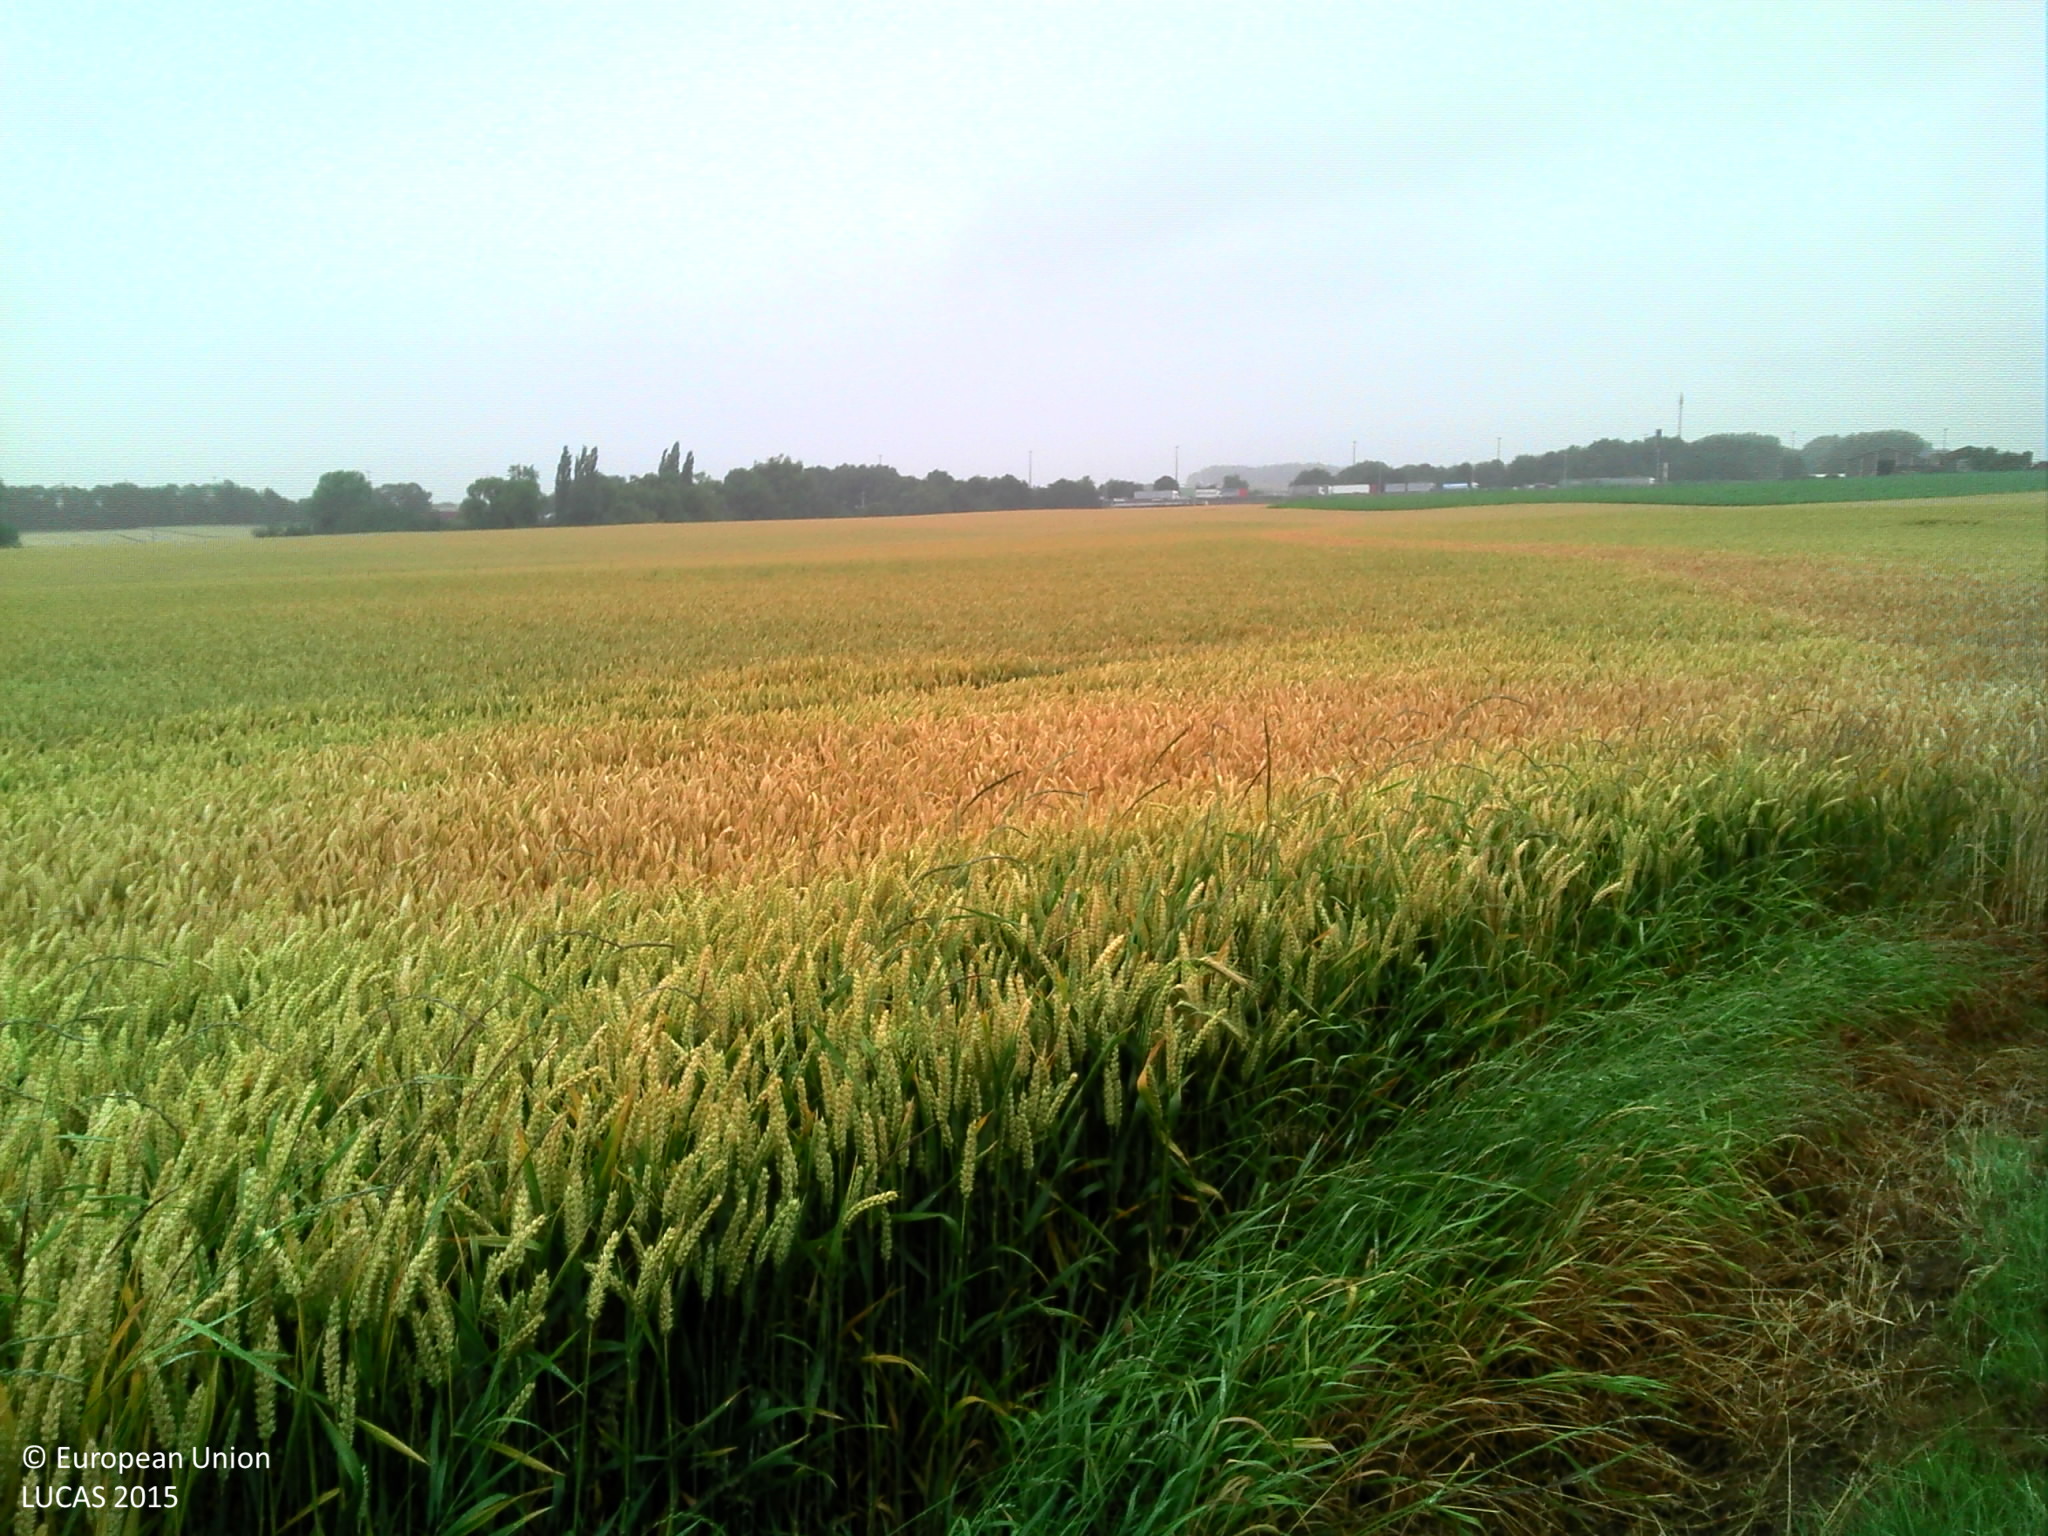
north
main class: Cropland
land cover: Common wheat
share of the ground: > 75 %
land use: Agriculture (excluding fallow land and kitchen gardens)
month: July
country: BE
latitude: 50.4817
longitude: 4.0896
